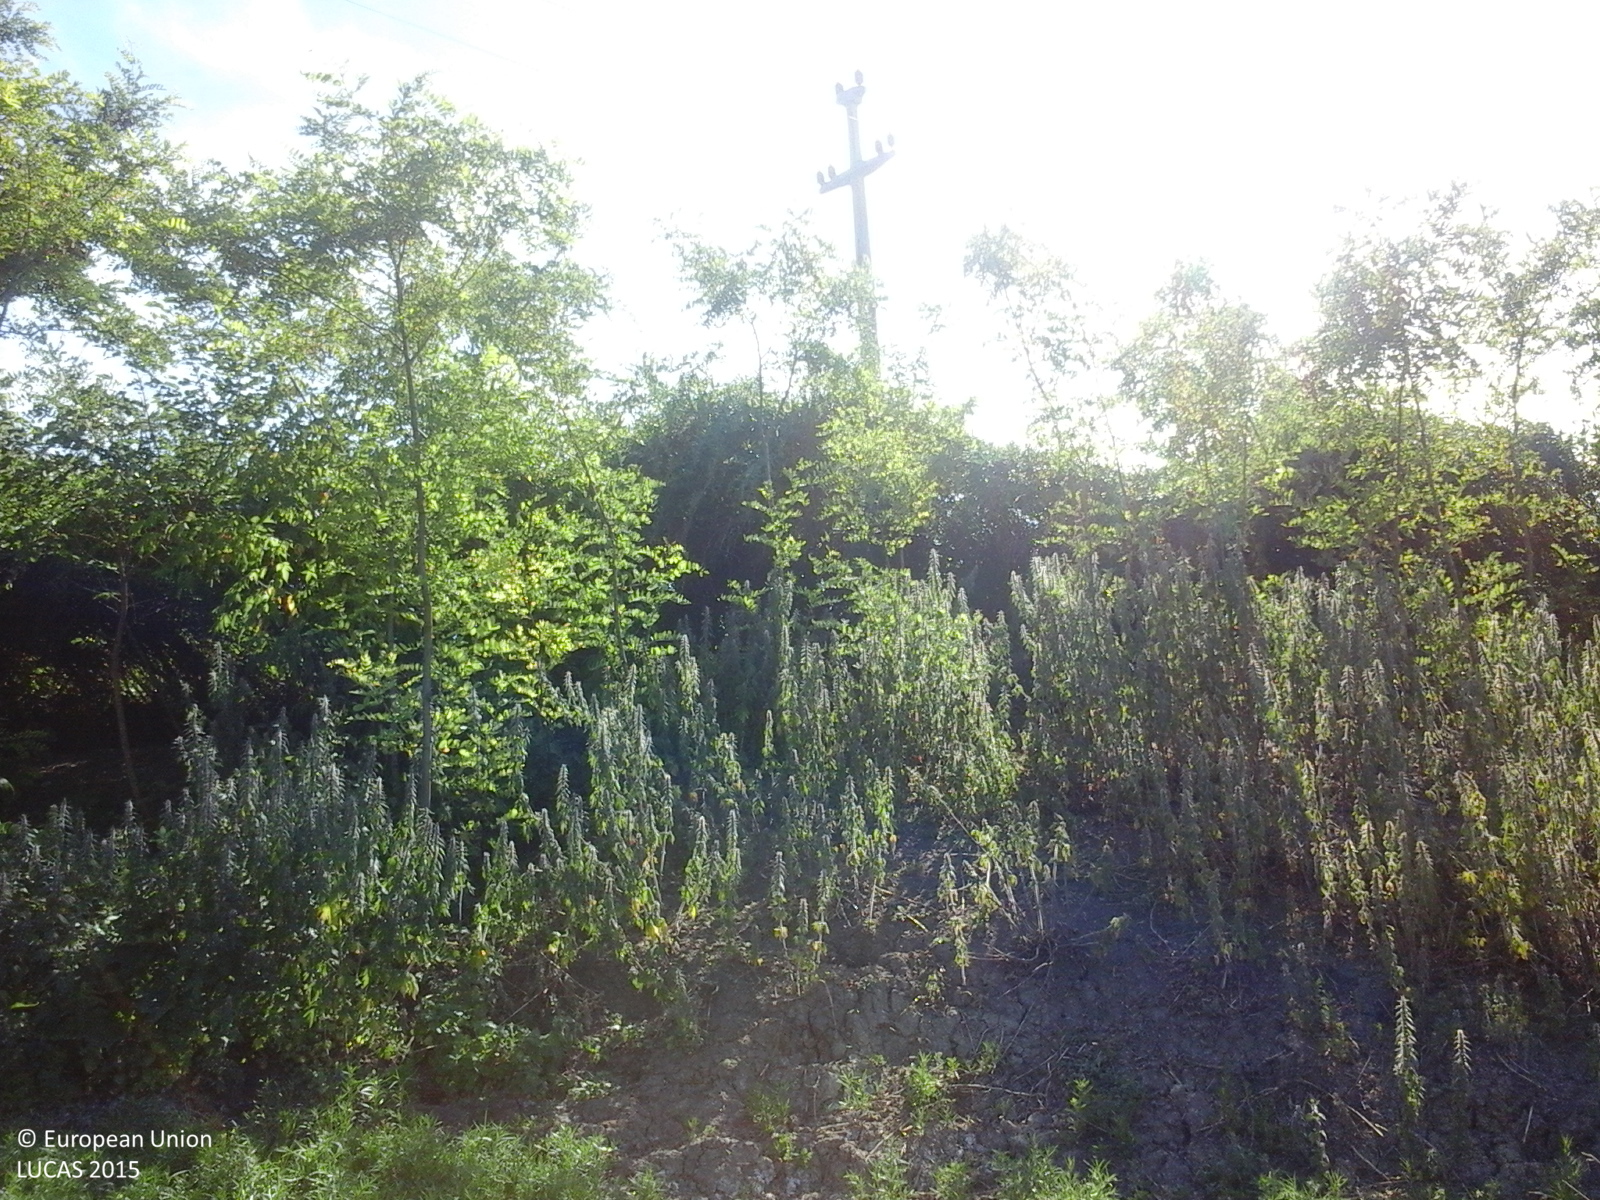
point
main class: Grassland
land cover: Spontaneously vegetated surfaces
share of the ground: > 75 %
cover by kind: herbaceous plants 100 %
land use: Agriculture (excluding fallow land and kitchen gardens)
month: June
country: RO
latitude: 47.2841
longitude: 27.0664
